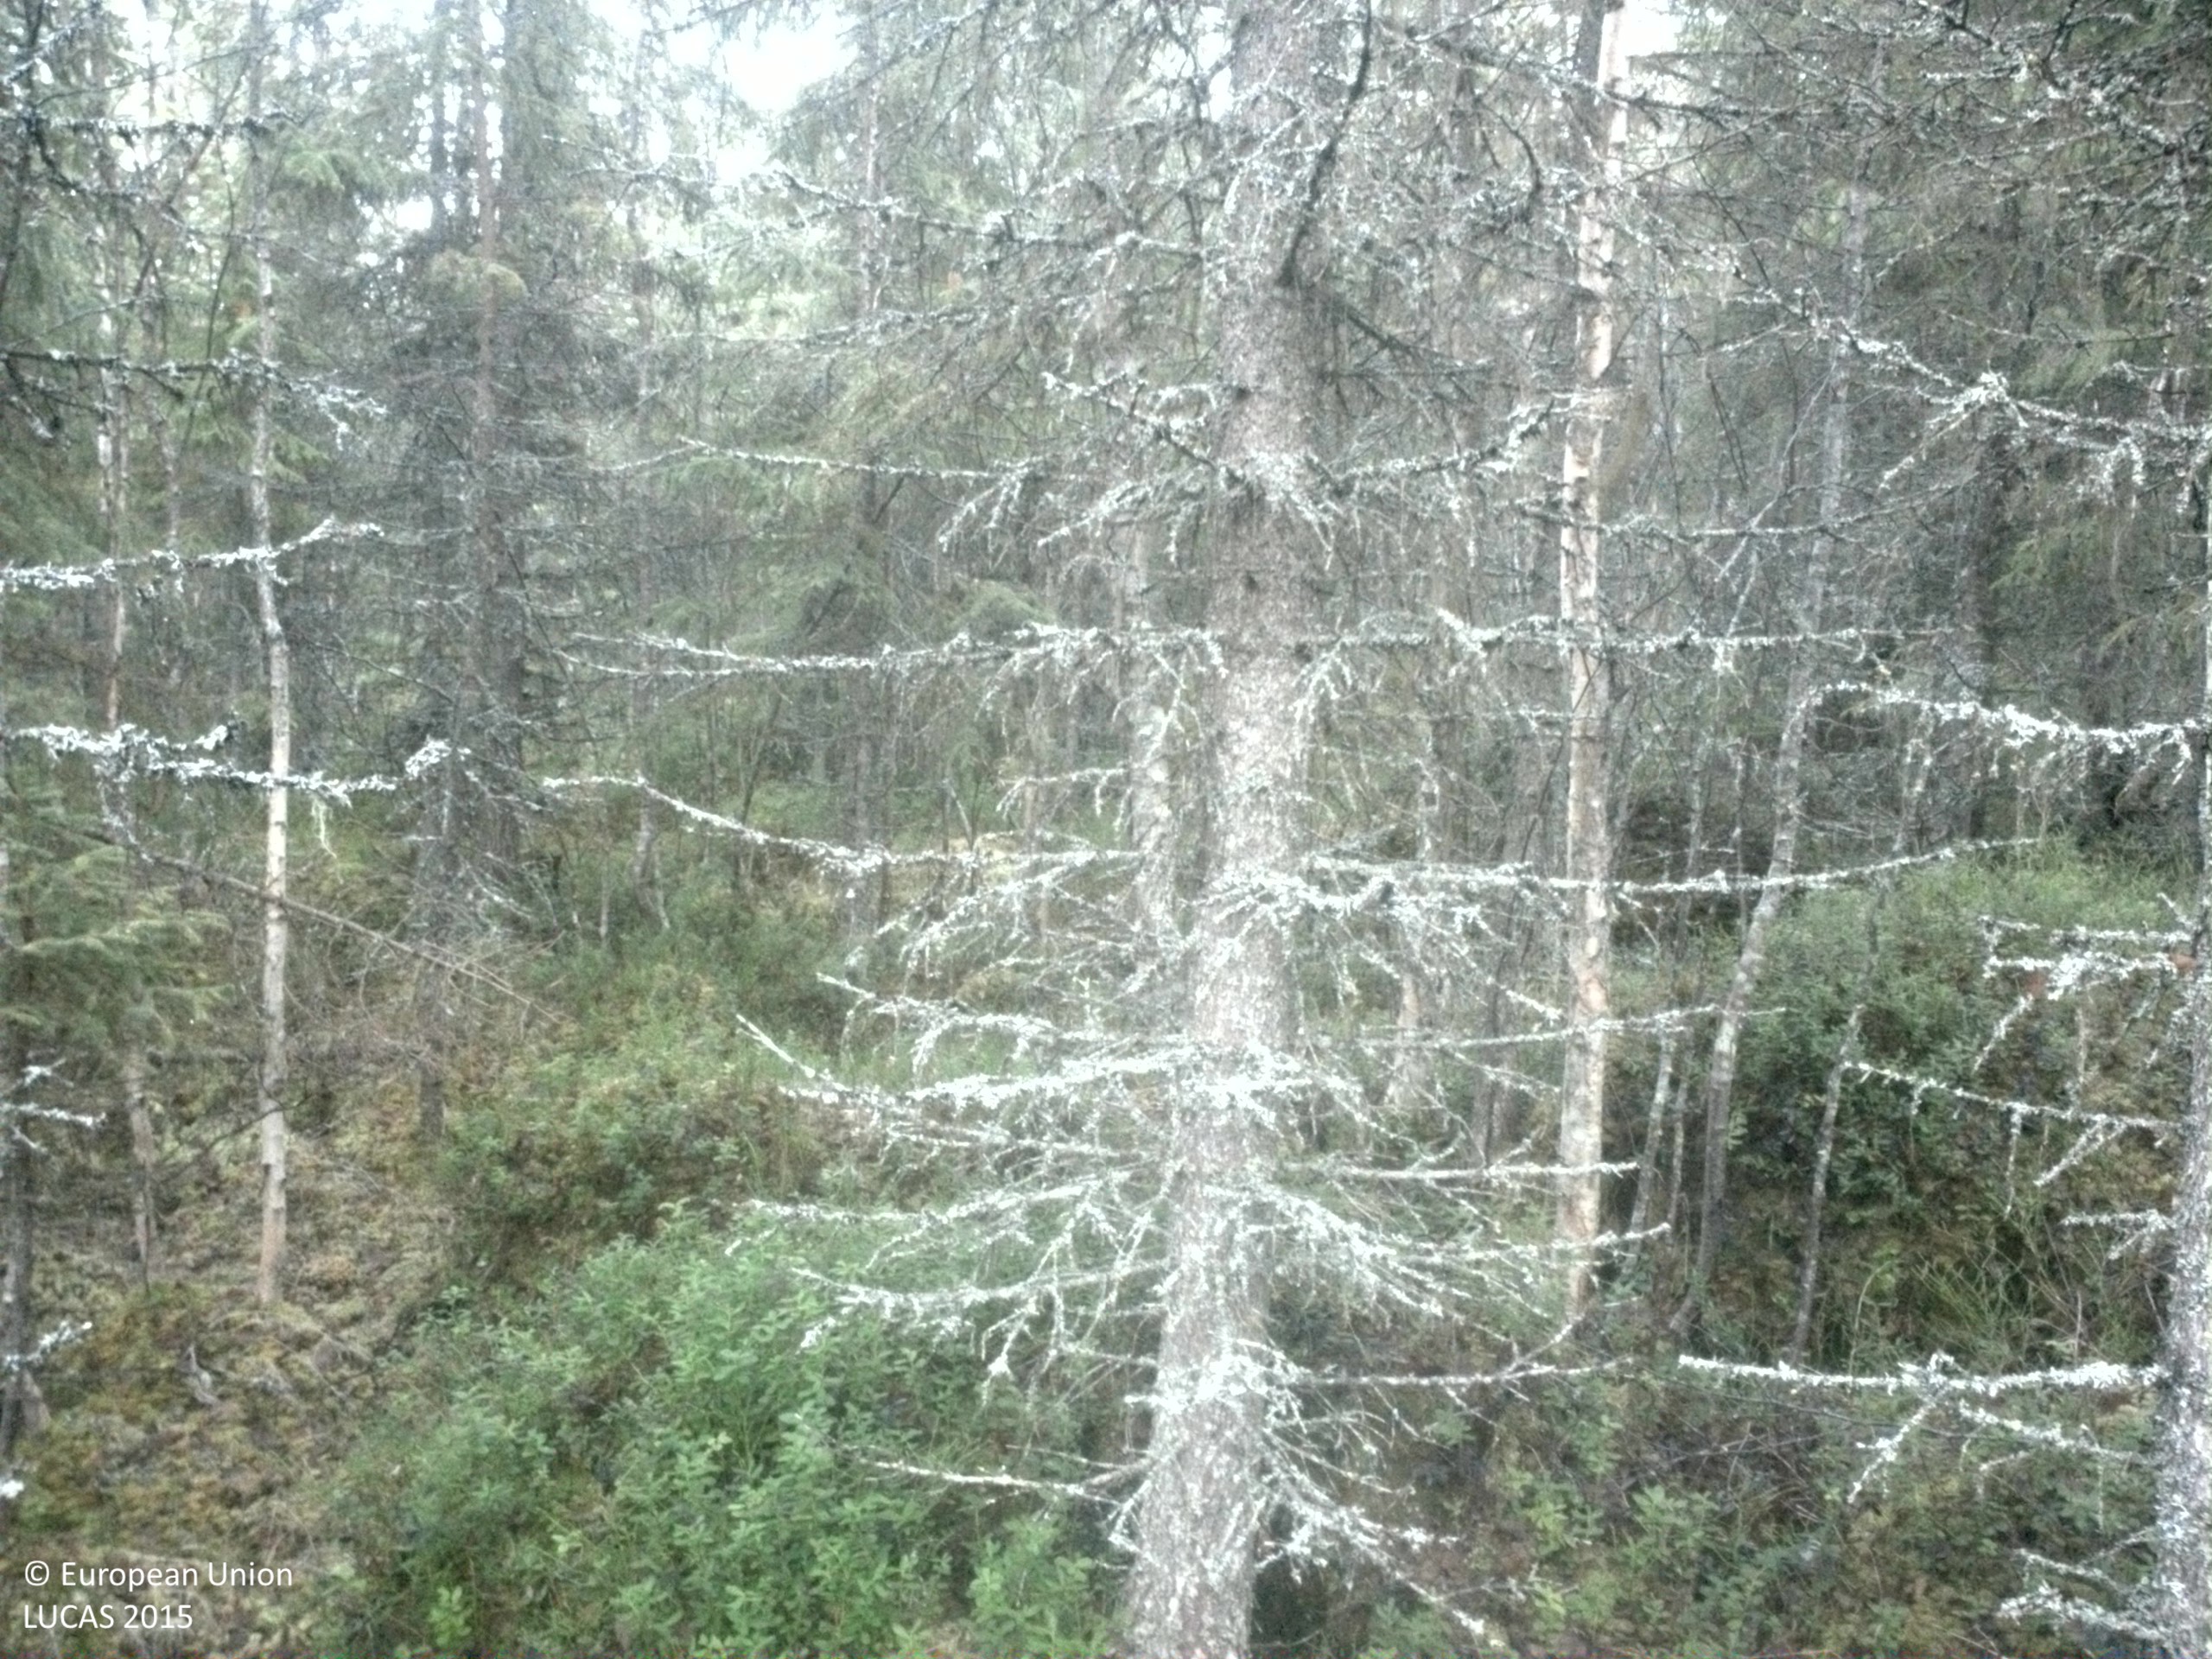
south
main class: Woodland
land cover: Spruce dominated mixed woodland
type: boreal forest
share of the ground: > 75 %
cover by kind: coniferous forest trees 55 %, broadleaved forest trees 20 %, shrubs 15 %, lichens and mosses 10 %
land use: Forestry
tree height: > 5 m
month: November
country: SE
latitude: 63.9081
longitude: 15.9025
